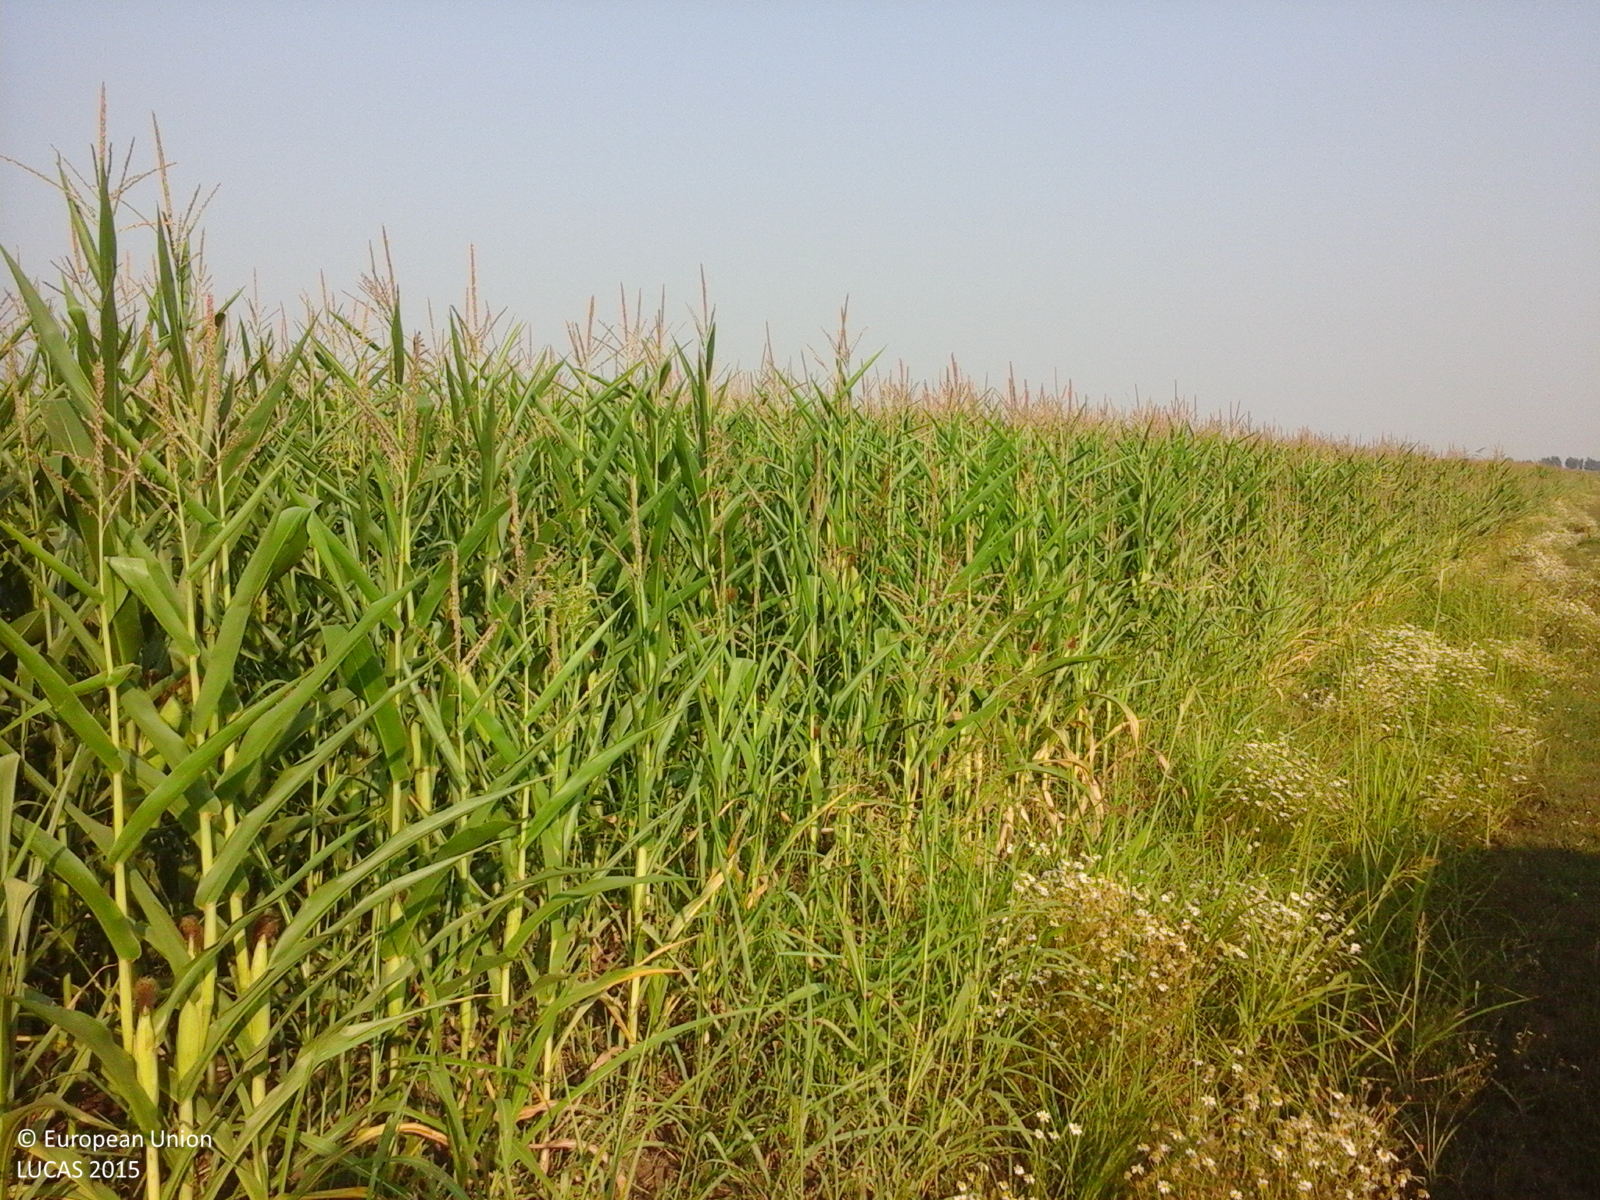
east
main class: Cropland
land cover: Maize
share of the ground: > 75 %
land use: Agriculture (excluding fallow land and kitchen gardens)
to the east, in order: Maize
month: July
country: RO
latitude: 44.4945
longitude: 26.5794
